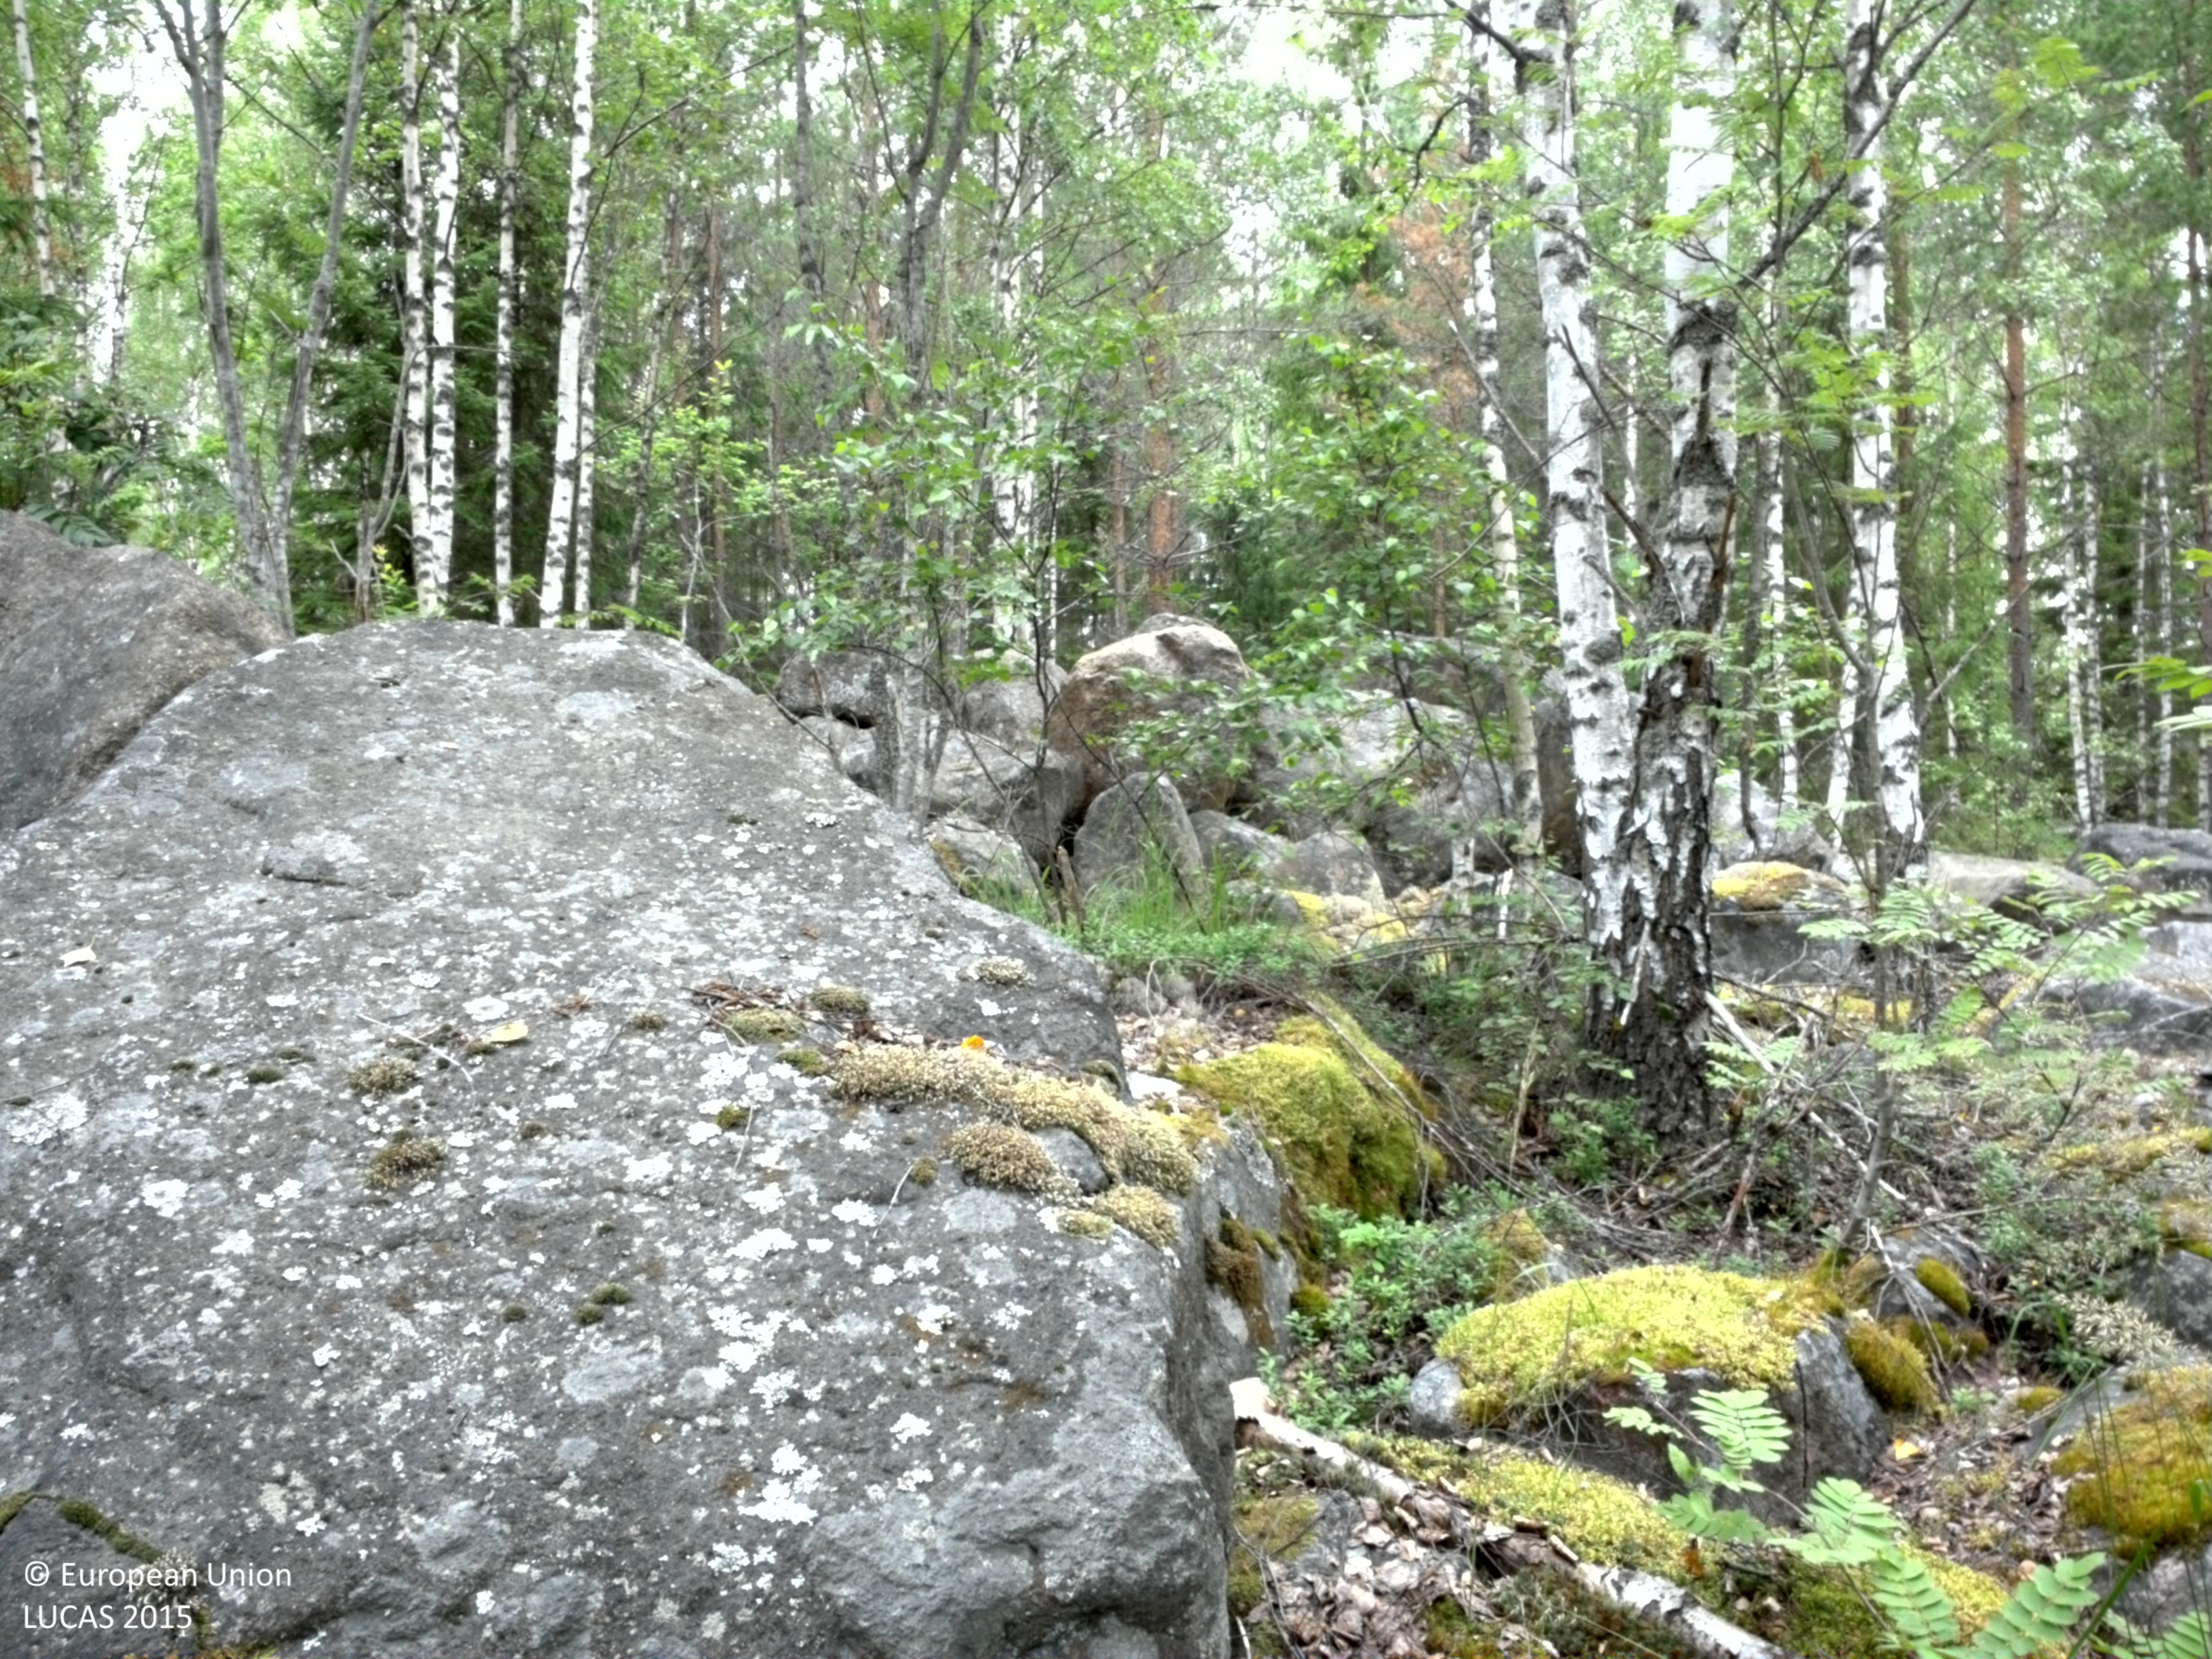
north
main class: Woodland
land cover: Spruce dominated mixed woodland
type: boreal forest
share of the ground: 50 - 75 %
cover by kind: coniferous forest trees 45 %, lichens and mosses 20 %, broadleaved forest trees 15 %, herbaceous plants 10 %, consolidated bare surface 10 %
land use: Forestry
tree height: > 5 m
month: July
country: SE
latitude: 59.7971
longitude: 18.4993
